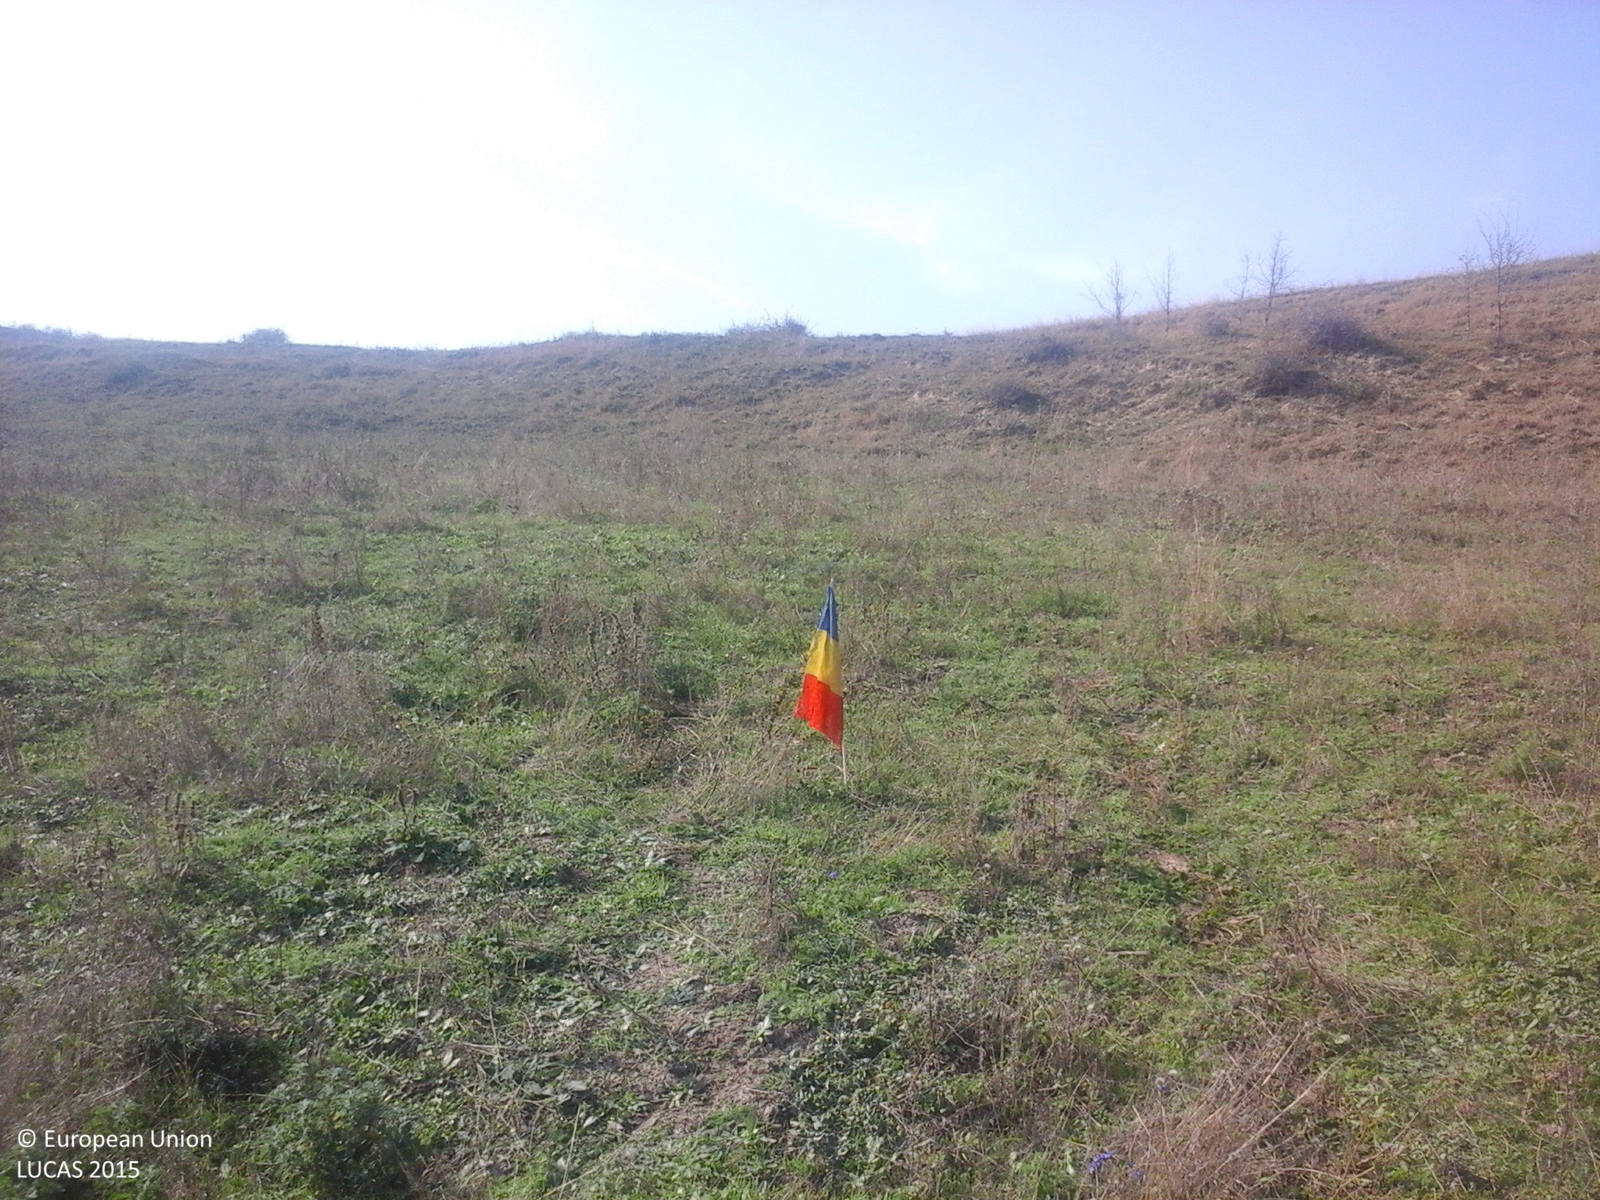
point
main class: Grassland
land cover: Spontaneously vegetated surfaces
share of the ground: > 75 %
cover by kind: herbaceous plants 100 %
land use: Fallow land
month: October
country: RO
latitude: 46.3288
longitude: 23.9344
